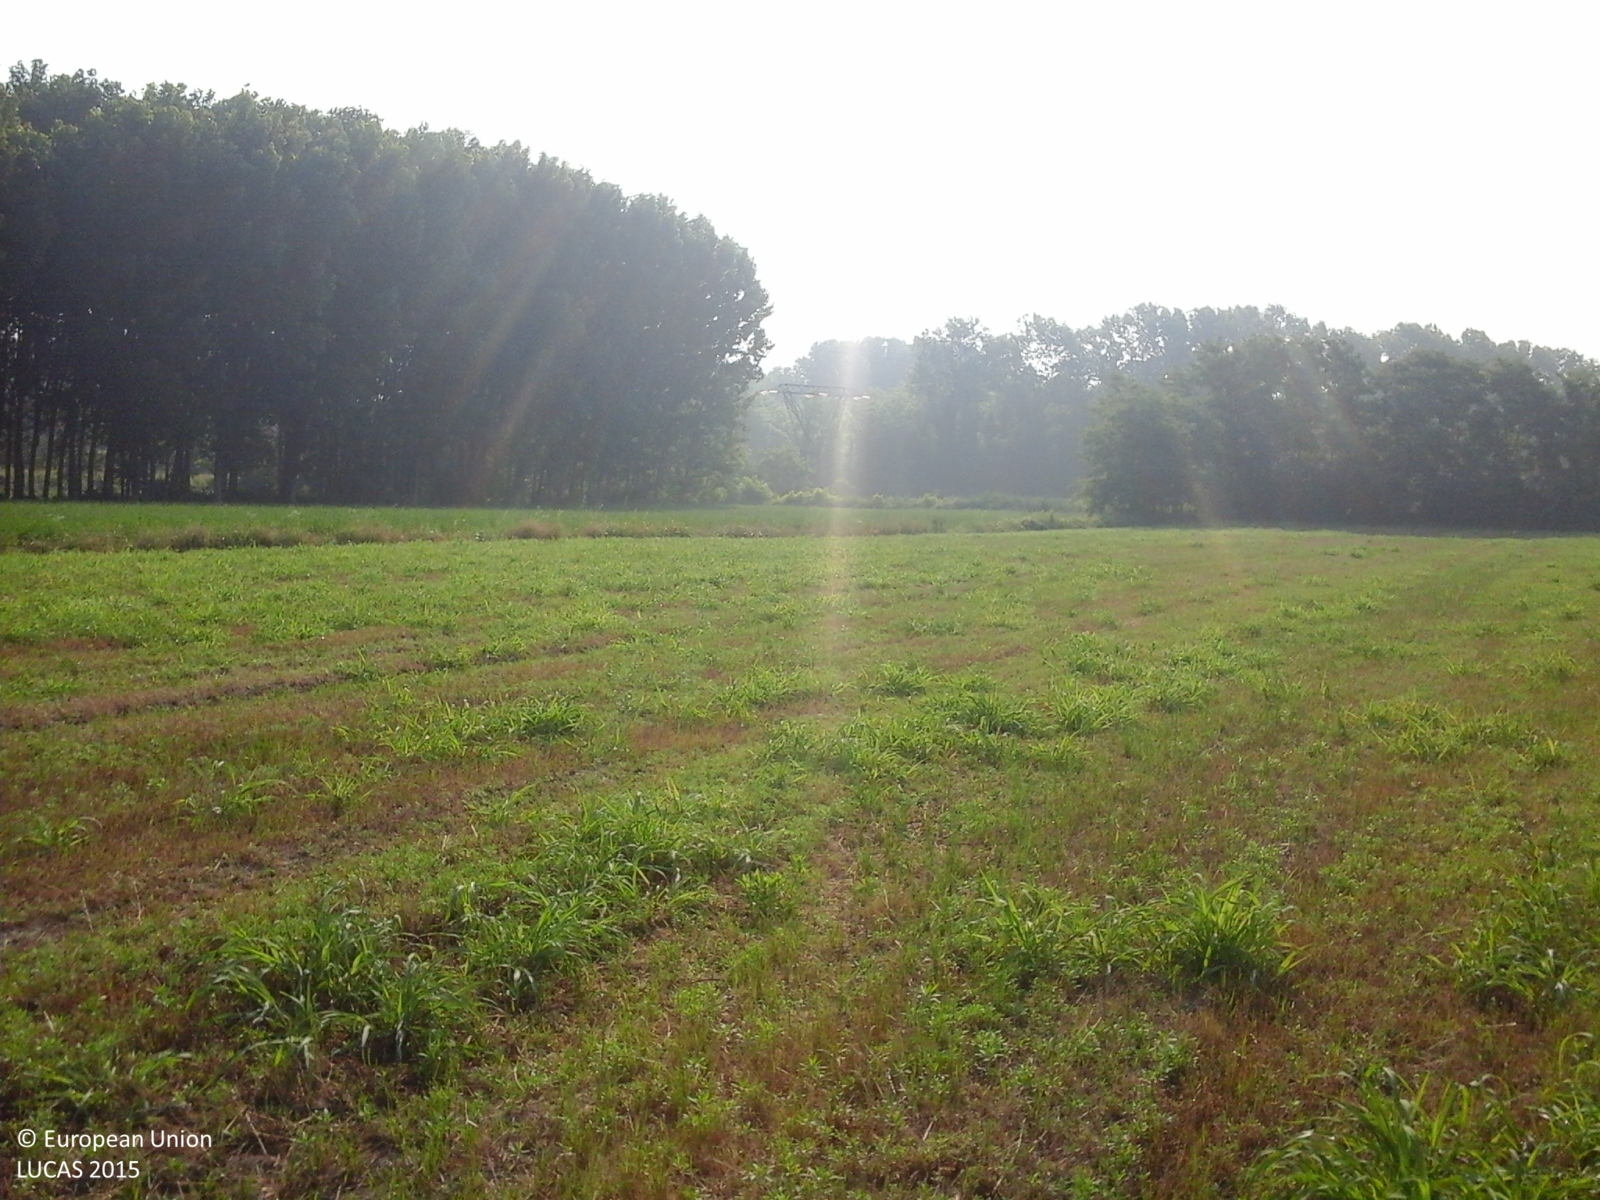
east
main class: Grassland
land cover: Spontaneously vegetated surfaces
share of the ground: > 75 %
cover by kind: herbaceous plants 100 %
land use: Fallow land
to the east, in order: Spontaneously vegetated surfaces; Ditches and canals; Lucerne; Managed hedges; Ditches and canals; Shrubland without tree cover; Electric lines; Tracks; Grass margins; Ditches and canals; Spontaneously vegetated surfaces; Ditches and canals; Broadleaved woodland
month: June
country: IT
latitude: 45.0717
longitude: 9.8606
